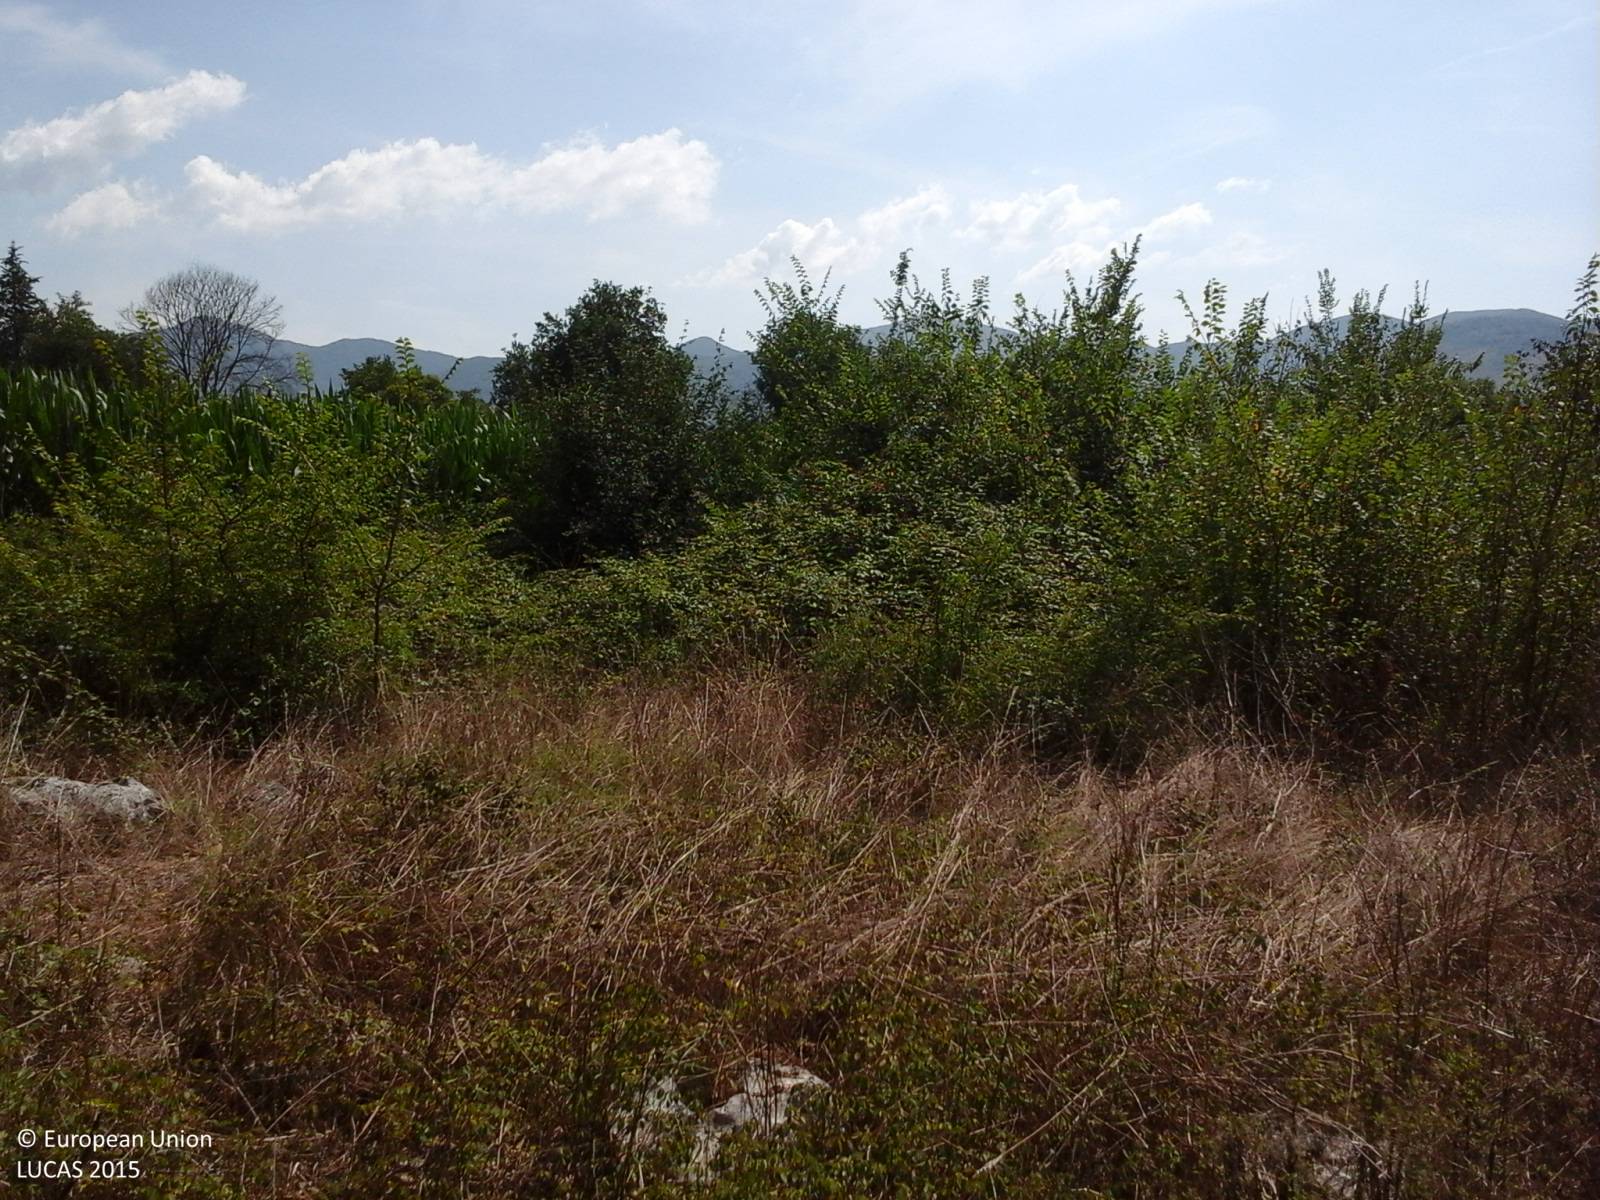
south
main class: Grassland
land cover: Grassland with sparse tree/shrub cover
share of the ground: > 75 %
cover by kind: herbaceous plants 75 %, unconsolidated bare surface 20 %, broadleaved forest trees 5 %
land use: Semi-natural and natural areas not in use
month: August
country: IT
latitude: 41.4782
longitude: 13.3282
